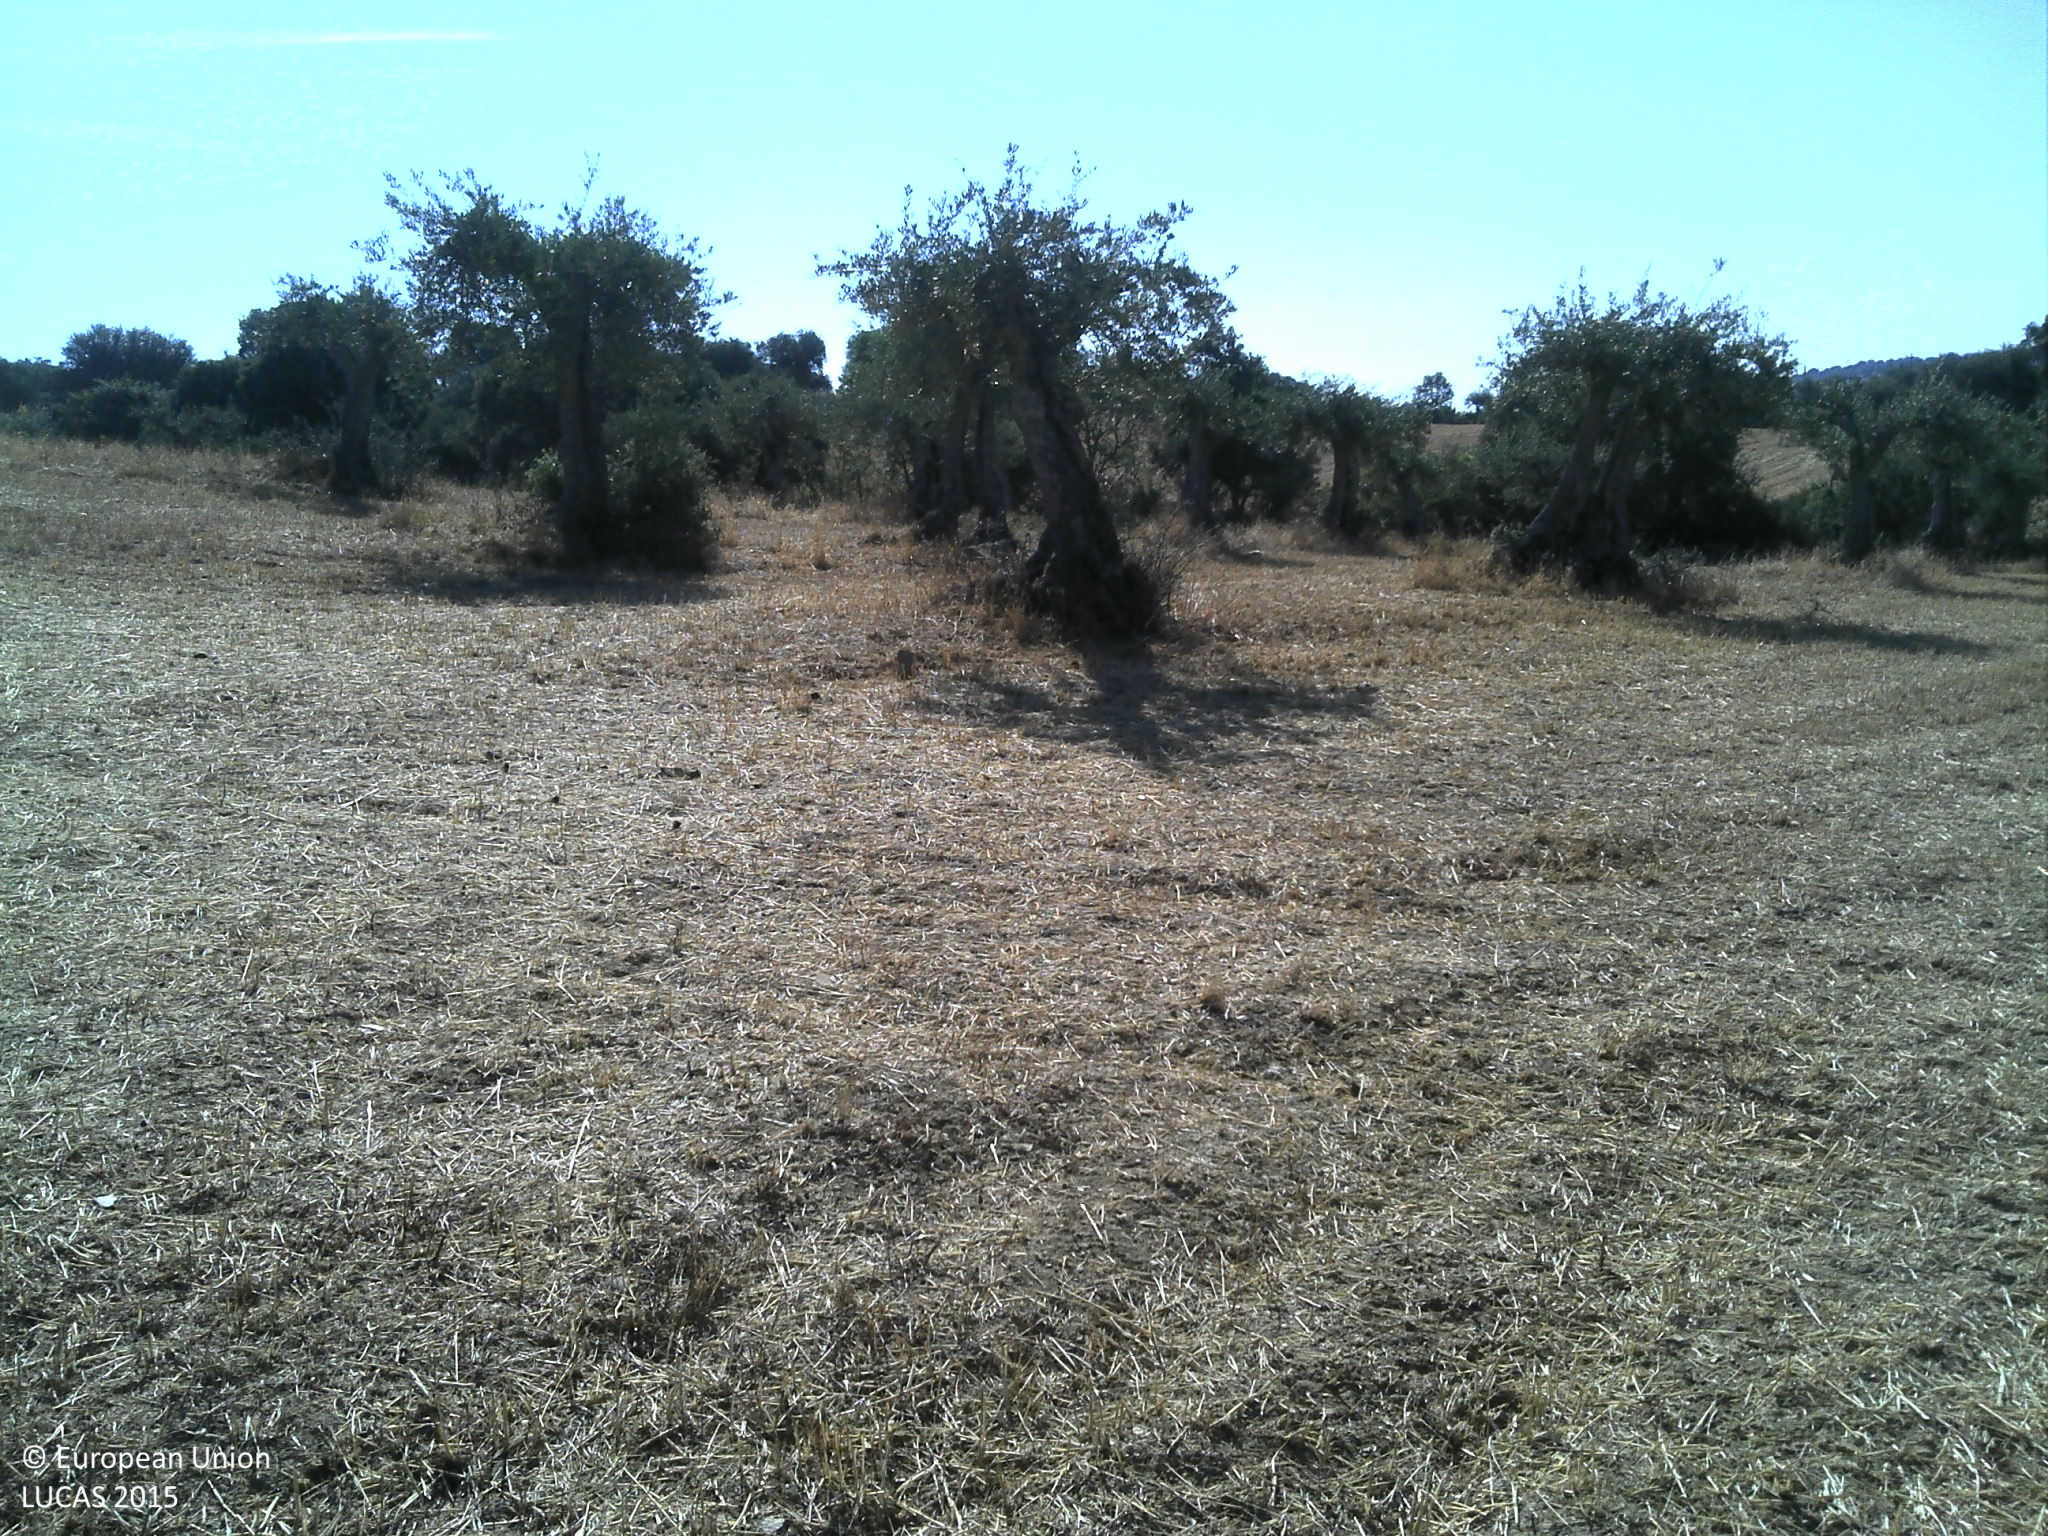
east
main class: Cropland
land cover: Oats
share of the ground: > 75 %
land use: Agriculture (excluding fallow land and kitchen gardens)
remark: Harvested field
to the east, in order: Oats; Olive groves; Grass margins; Abandoned hedges; Dry stone walls; Abandoned hedges; Oats; Abandoned hedges; Grass margins; Artificial constructions; Fences; Ditches and canals; Paved roads, cycling and walking lanes; Ditches and canals; Artificial constructions; Olive groves; Abandoned hedges; Tracks; Dry stone walls; Fences; Olive groves
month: June
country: PT
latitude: 40.8460
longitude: -6.8363
